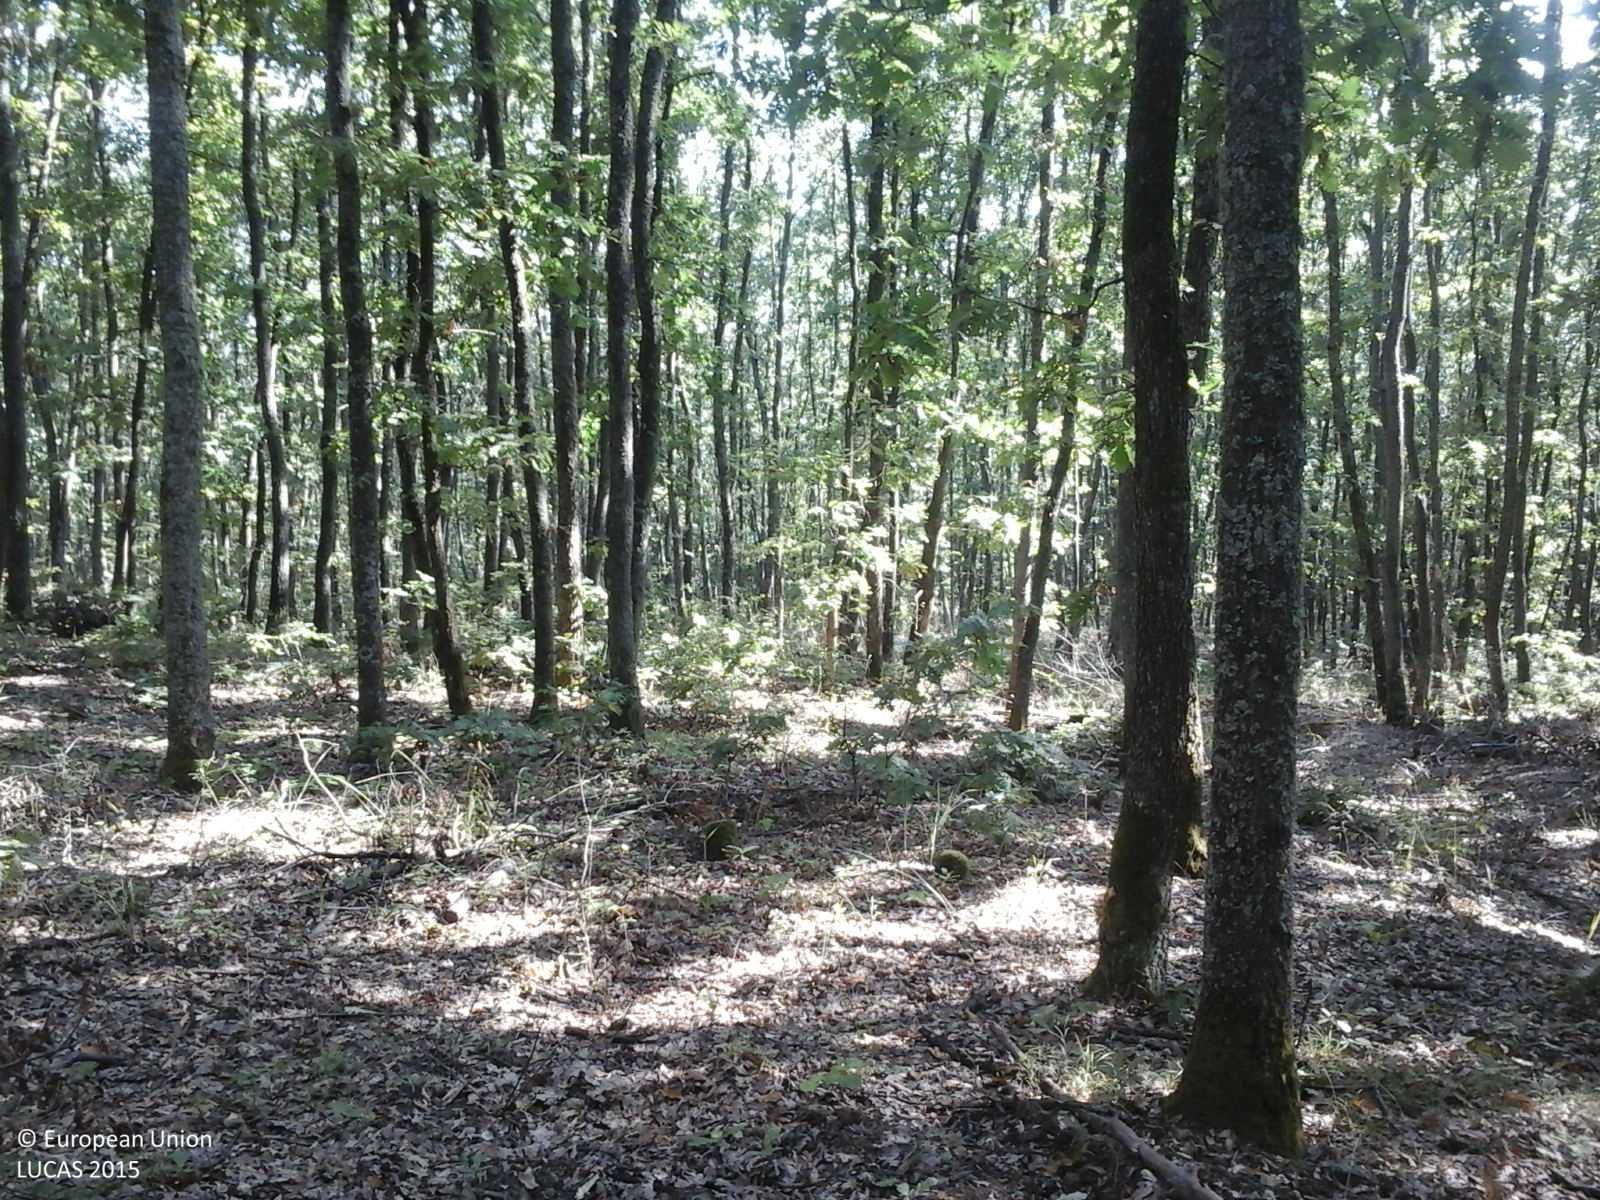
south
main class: Woodland
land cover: Broadleaved woodland
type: acidophilous oak and oak-birch forest
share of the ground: > 75 %
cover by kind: broadleaved forest trees 100 %
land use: Forestry
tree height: > 5 m
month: August
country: RO
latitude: 45.9654
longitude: 21.6638
